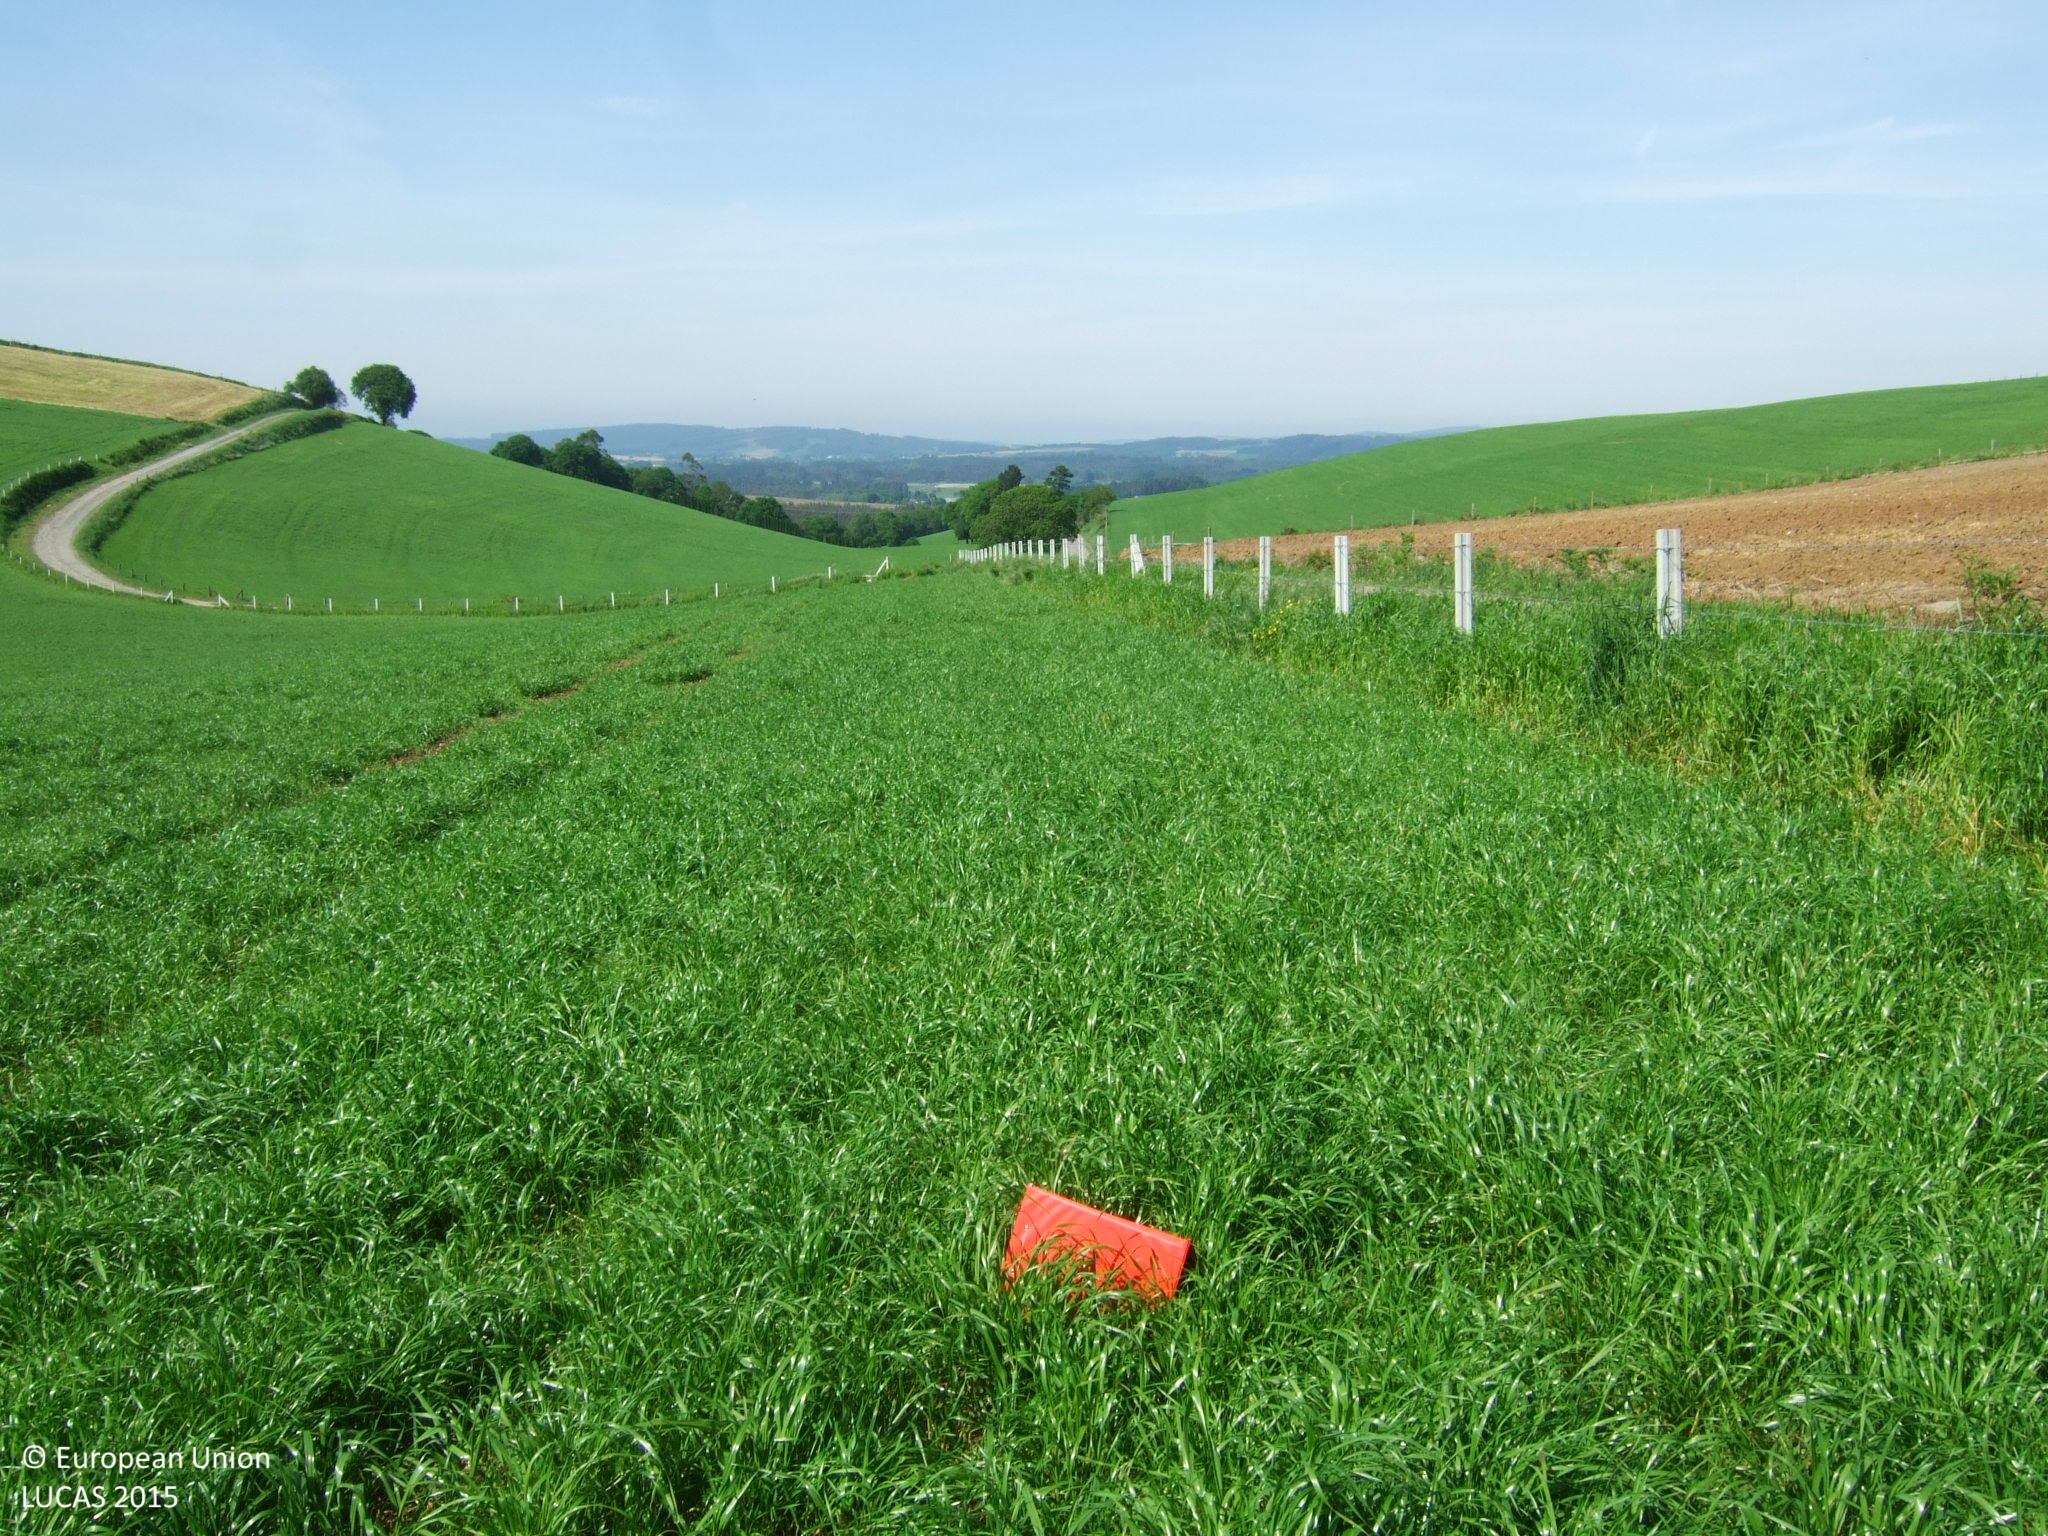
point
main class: Cropland
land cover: Temporary grasslands
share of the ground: > 75 %
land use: Agriculture (excluding fallow land and kitchen gardens)
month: May
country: ES
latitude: 43.1298
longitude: -7.3693
